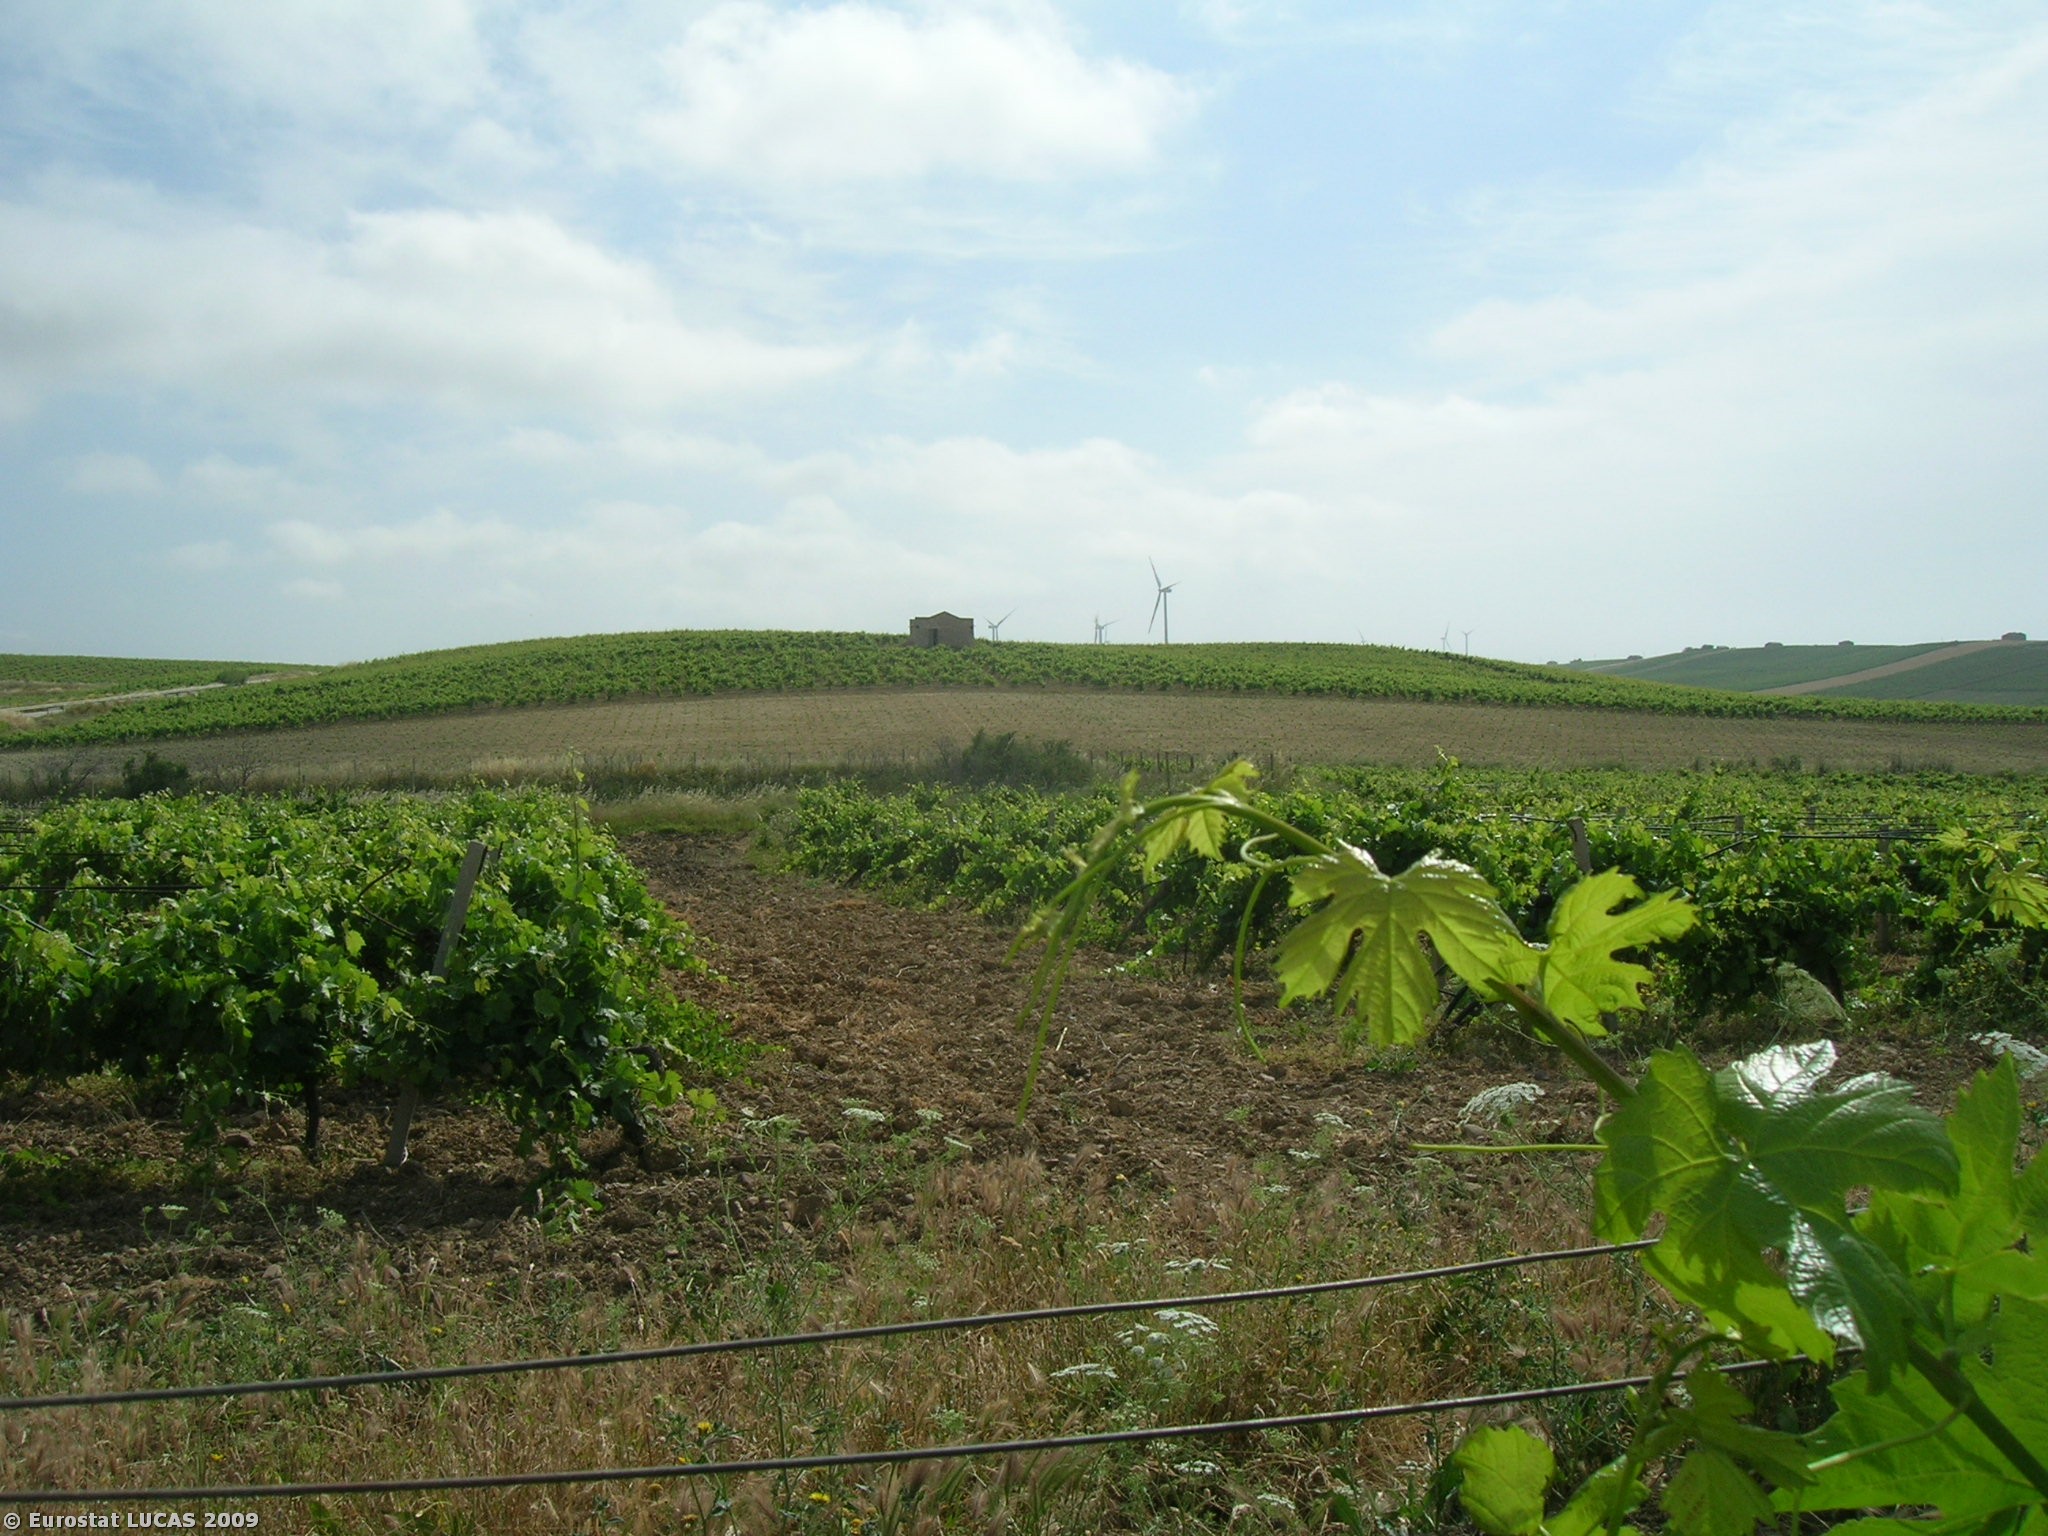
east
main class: Cropland
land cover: Vineyards
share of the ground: 50 - 75 %
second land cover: Bare land
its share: 50 - 75 %
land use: Agriculture (excluding fallow land and kitchen gardens)
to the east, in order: Vineyards; Bare land; Grass margins; Paved roads, cycling and walking lanes; Grass margins; Vineyards; Grass margins; Ditches and canals; Vineyards
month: May
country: IT
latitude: 37.8190
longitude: 12.6725
